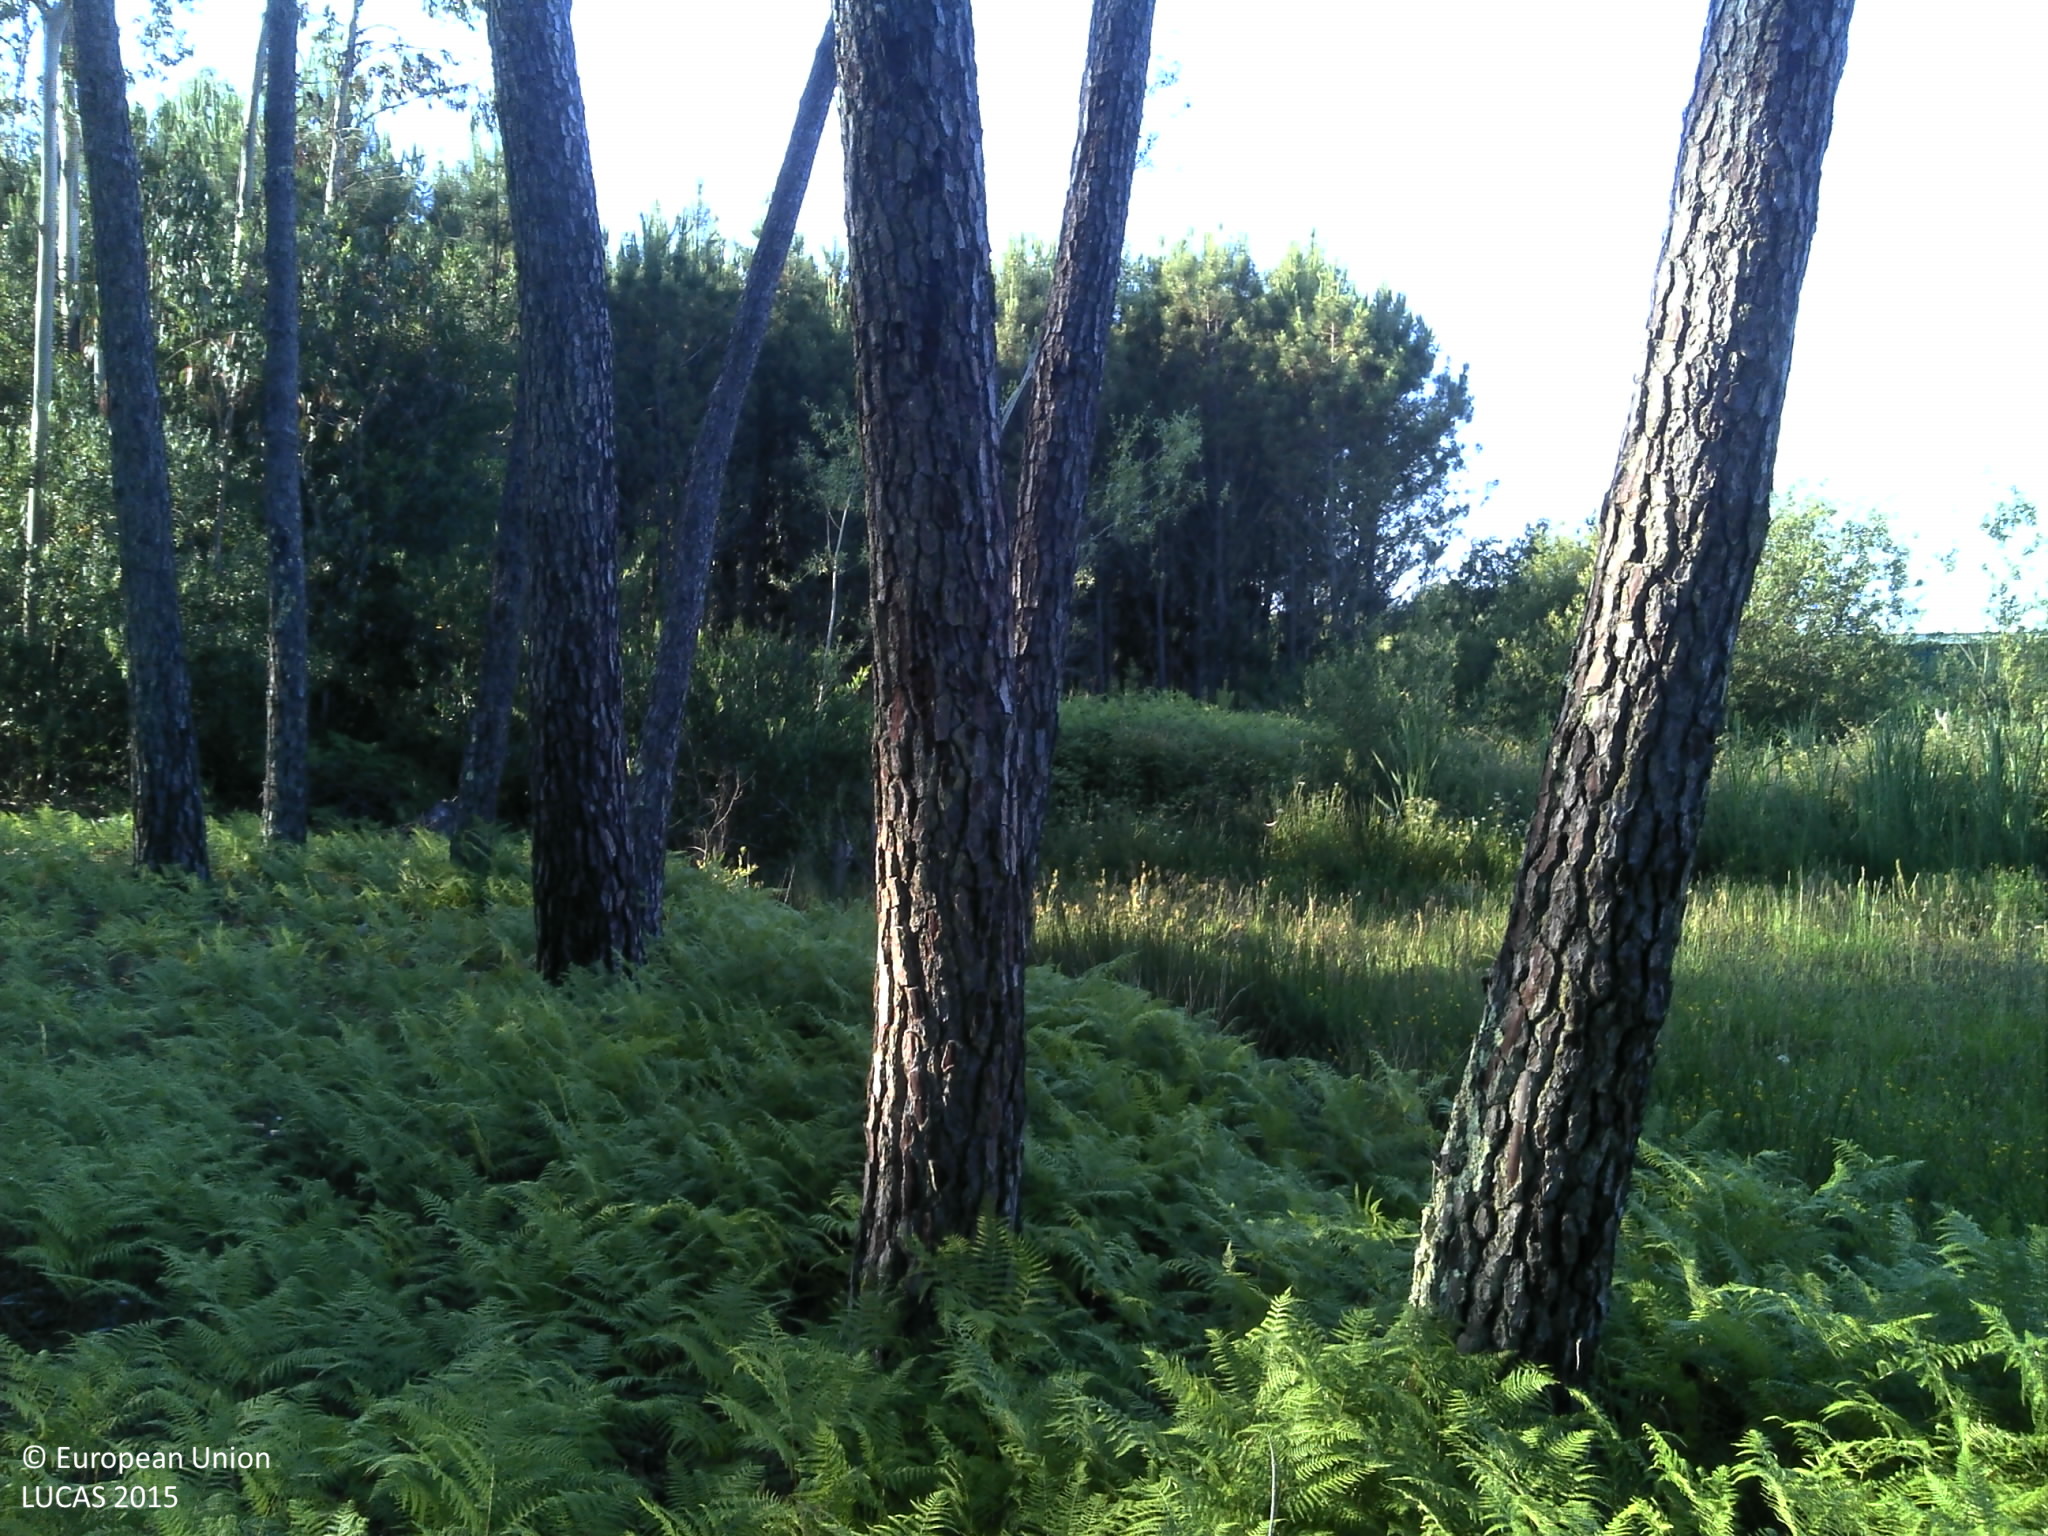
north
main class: Woodland
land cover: Pine dominated coniferous woodland
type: coniferous forest of the mediterranean region
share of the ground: 50 - 75 %
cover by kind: coniferous forest trees 75 %, shrubs 10 %, herbaceous plants 10 %, unconsolidated bare surface 5 %
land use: Forestry
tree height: > 5 m
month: May
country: PT
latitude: 40.4169
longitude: -8.6798
